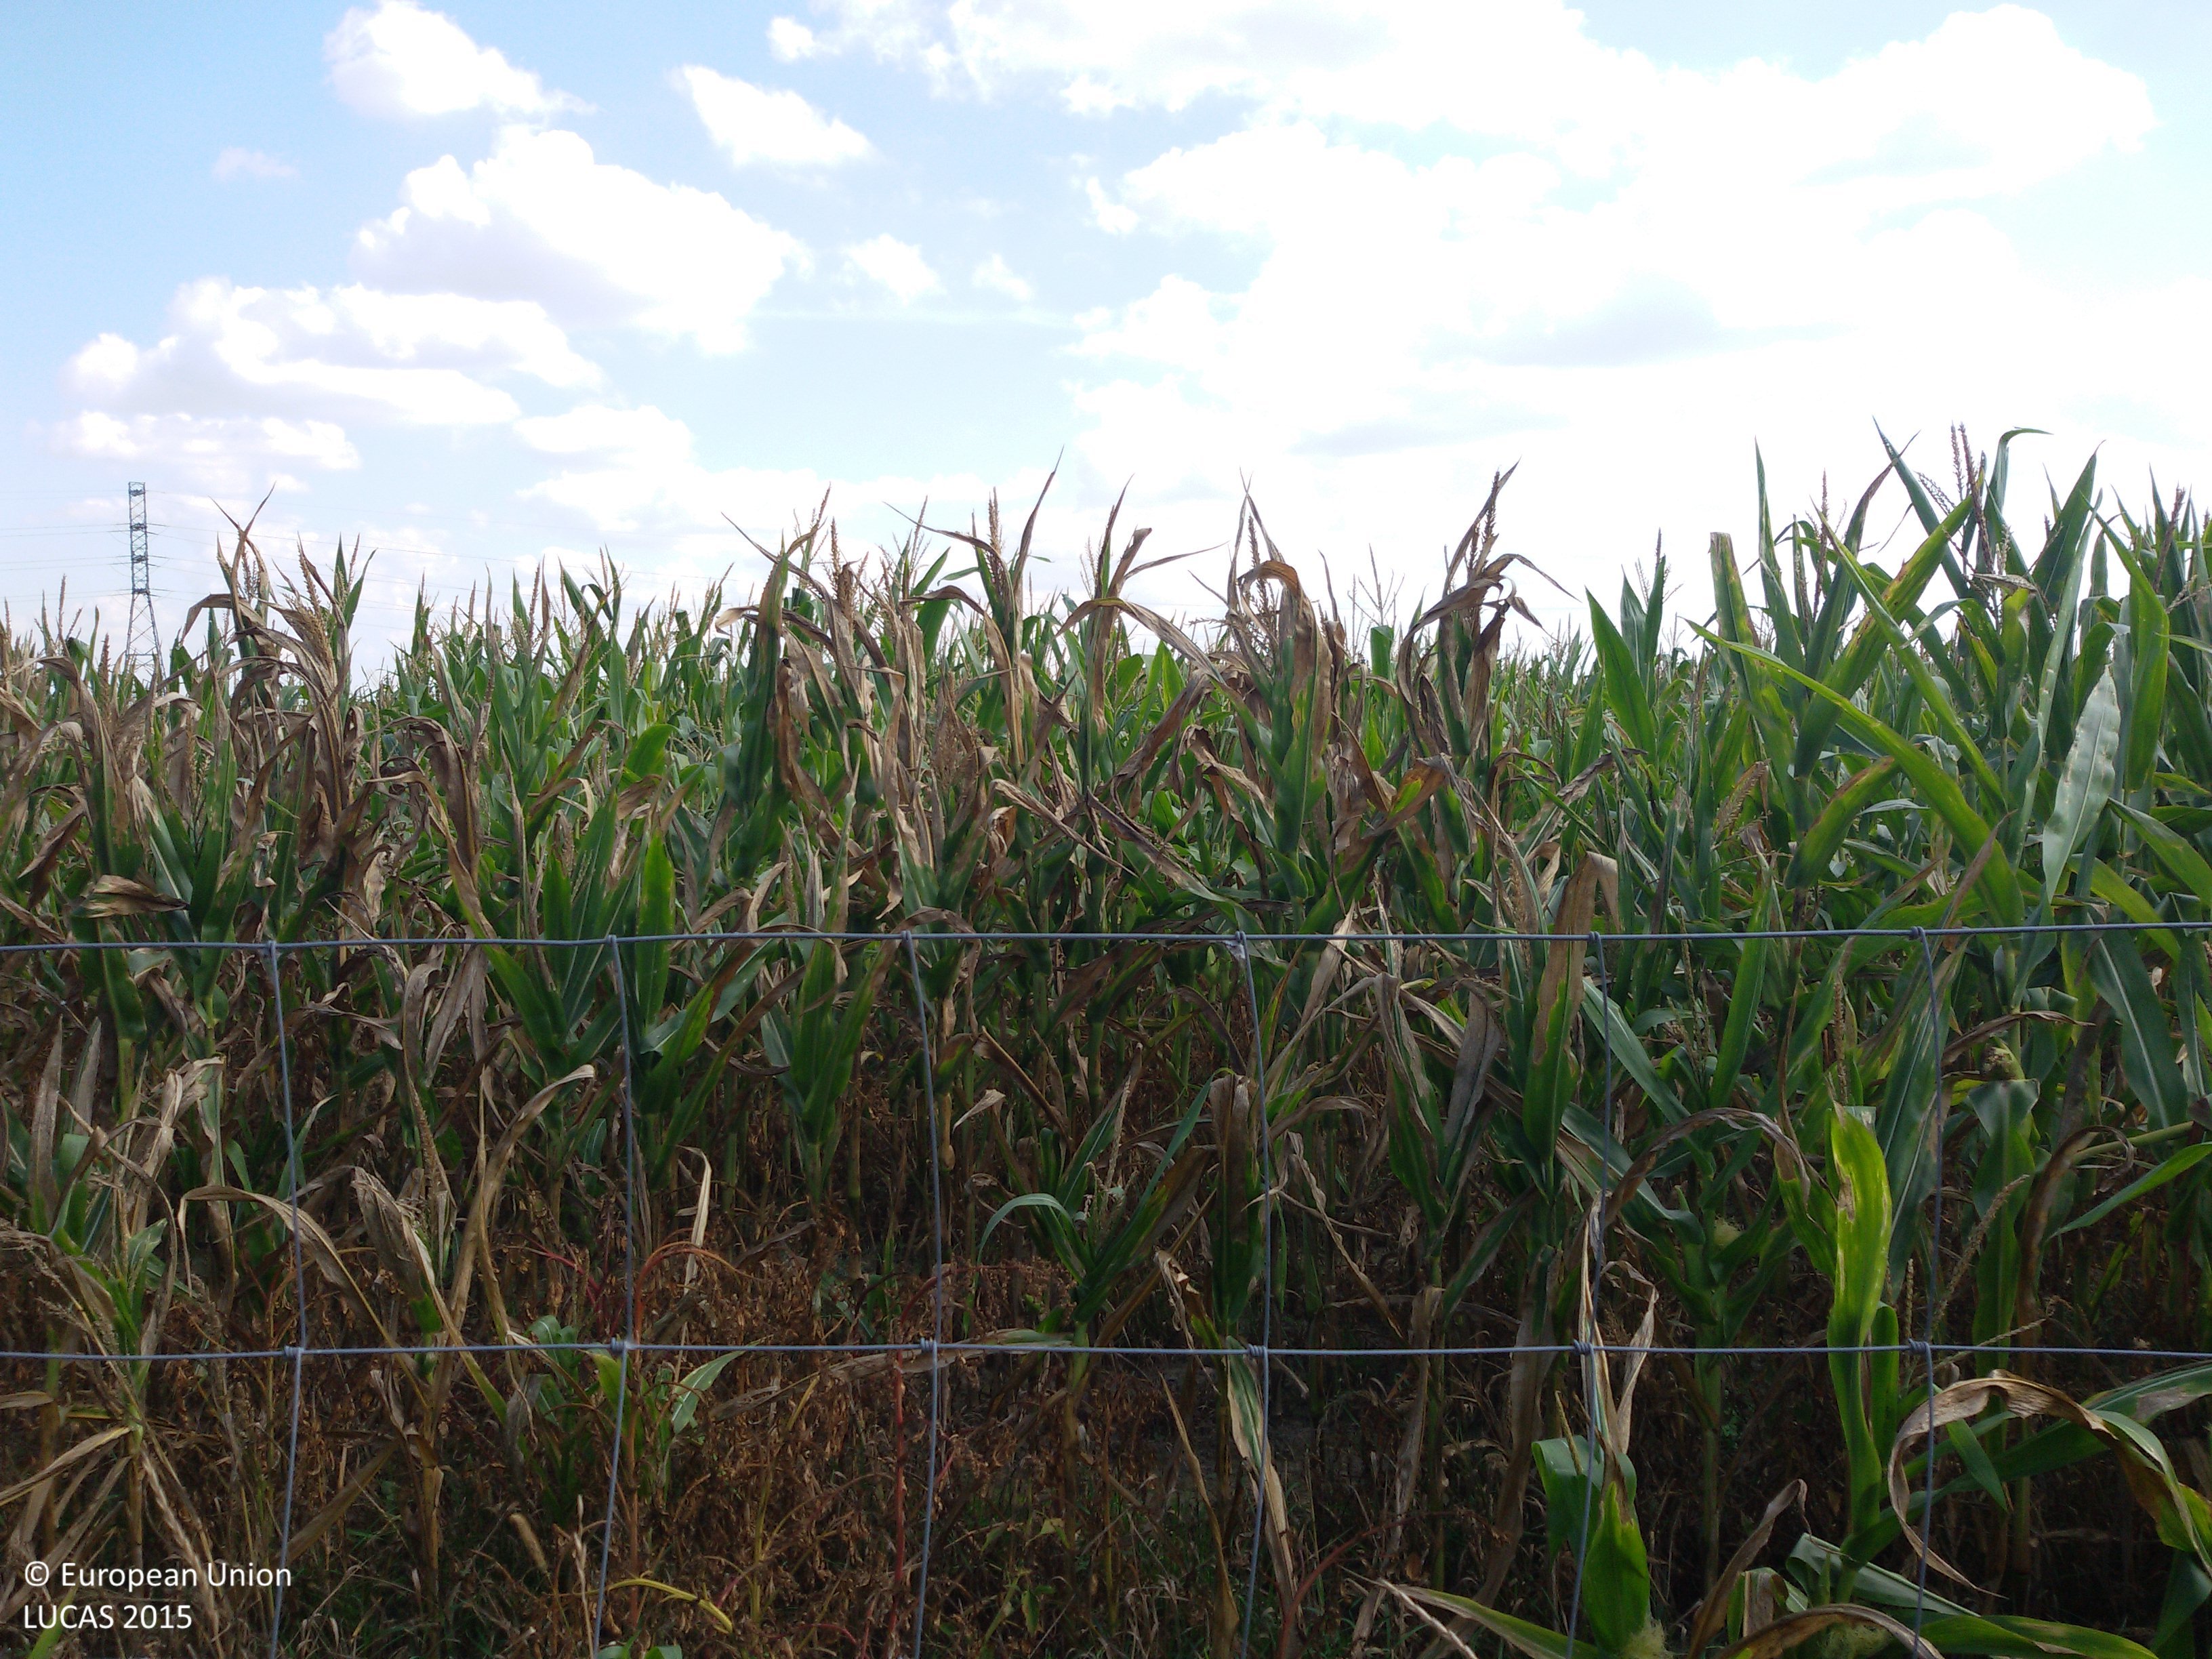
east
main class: Cropland
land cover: Maize
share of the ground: > 75 %
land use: Agriculture (excluding fallow land and kitchen gardens)
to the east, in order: Maize; Fences; Grass margins; Rye; Maize; Electric lines; Maize
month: September
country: PL
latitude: 52.1289
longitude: 17.9474
